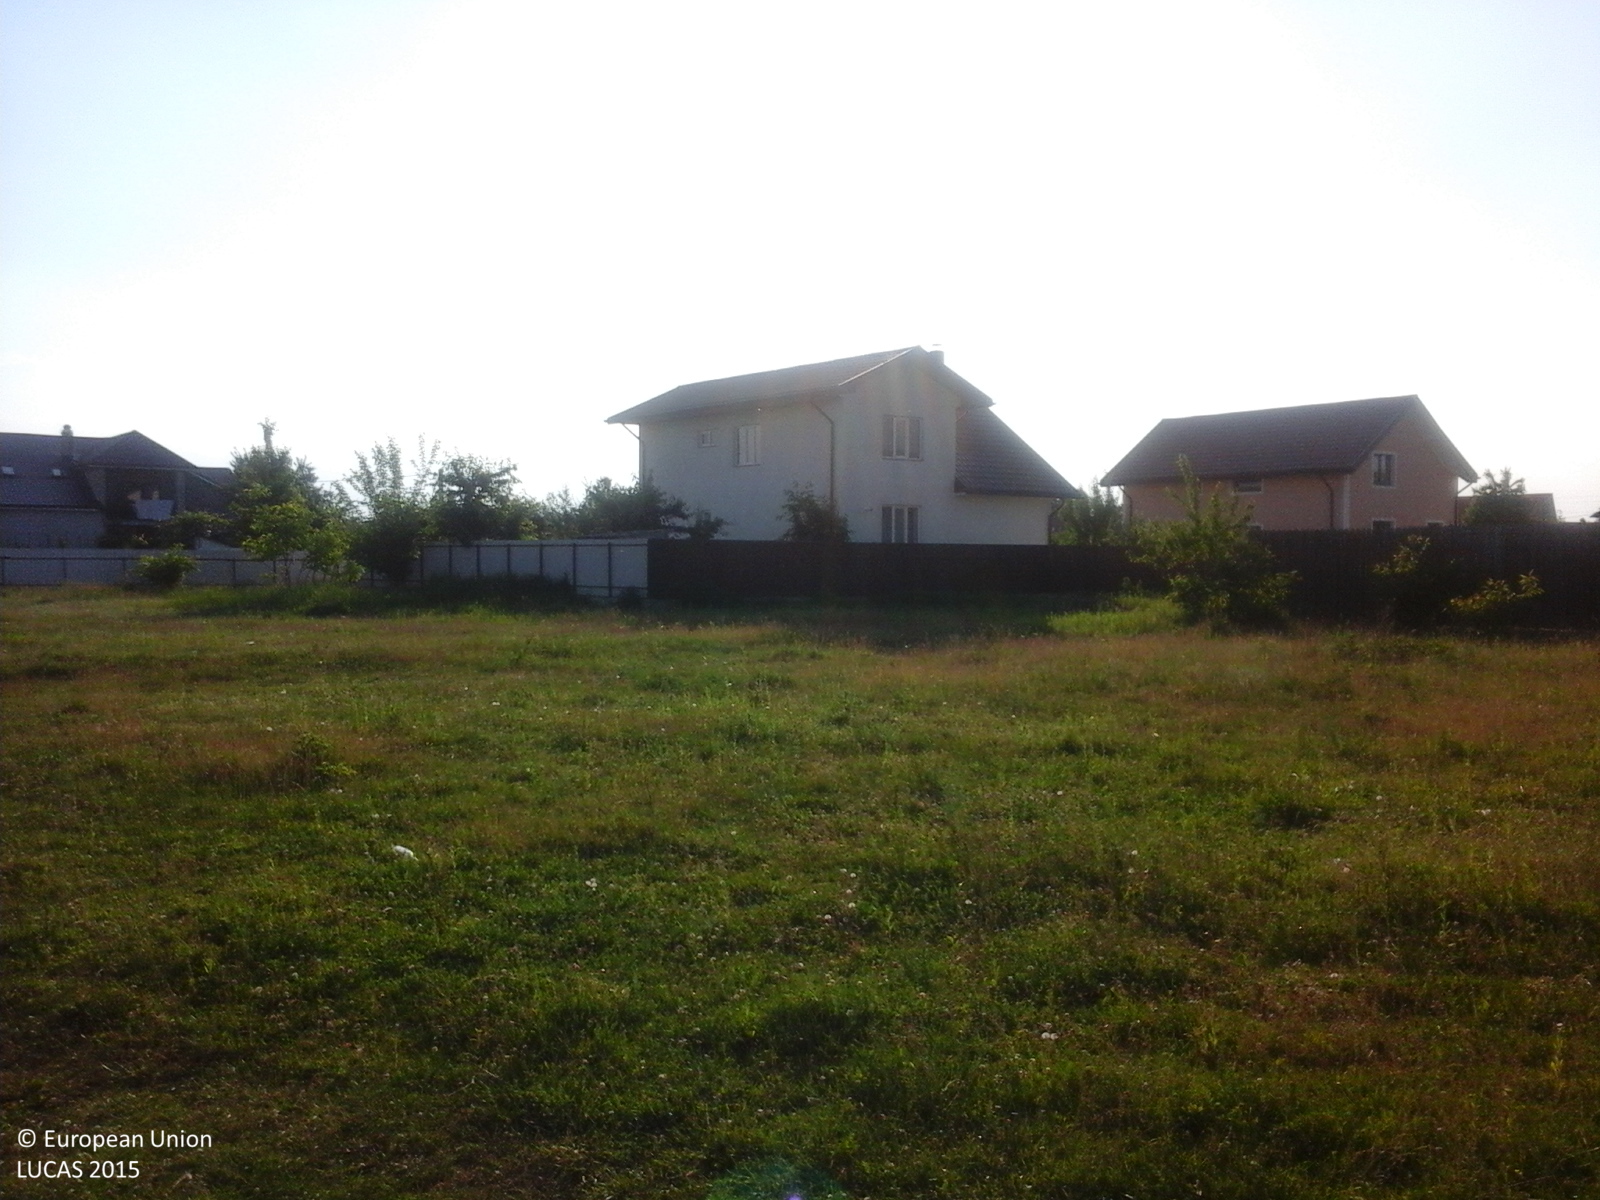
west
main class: Grassland
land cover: Grassland without tree/shrub cover
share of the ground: > 75 %
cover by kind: herbaceous plants 100 %
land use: Agriculture (excluding fallow land and kitchen gardens)
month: June
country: RO
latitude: 46.5865
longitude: 26.9437
